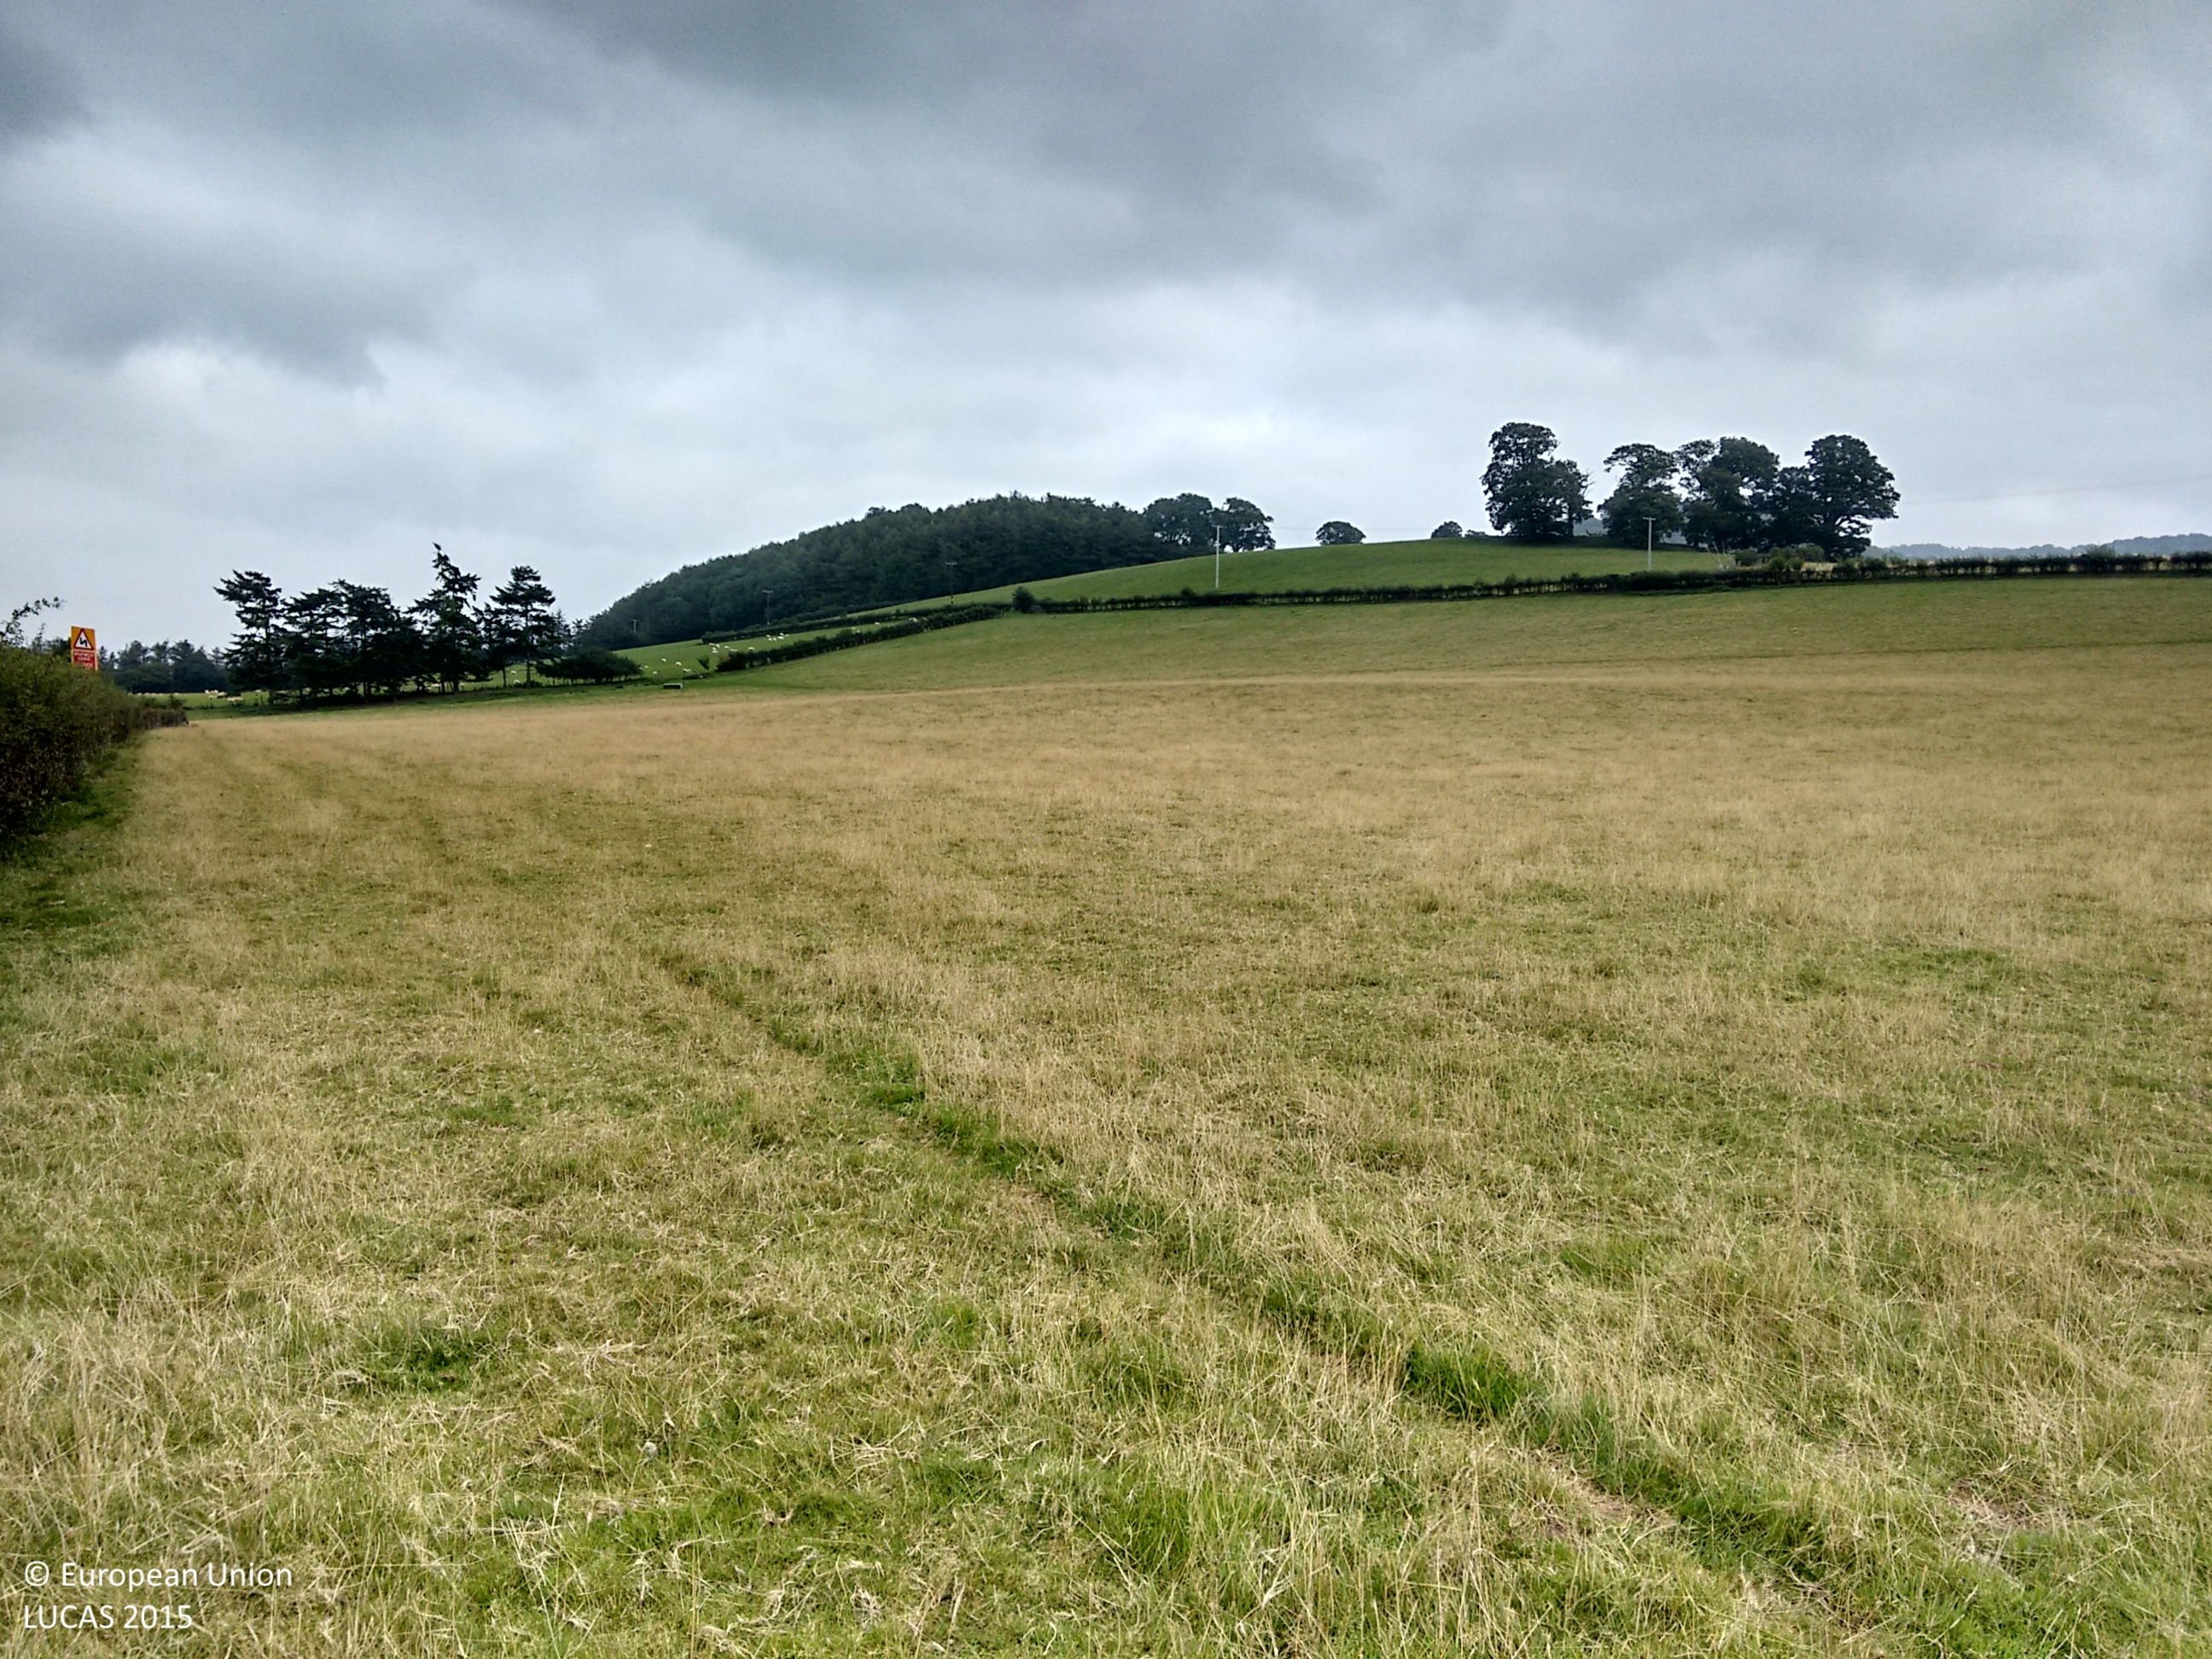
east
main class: Grassland
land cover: Grassland without tree/shrub cover
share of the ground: > 75 %
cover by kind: herbaceous plants 100 %
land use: Agriculture (excluding fallow land and kitchen gardens)
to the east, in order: Managed hedges; Fences; Grassland without tree/shrub cover
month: September
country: GB
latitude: 52.0598
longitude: -3.1611
